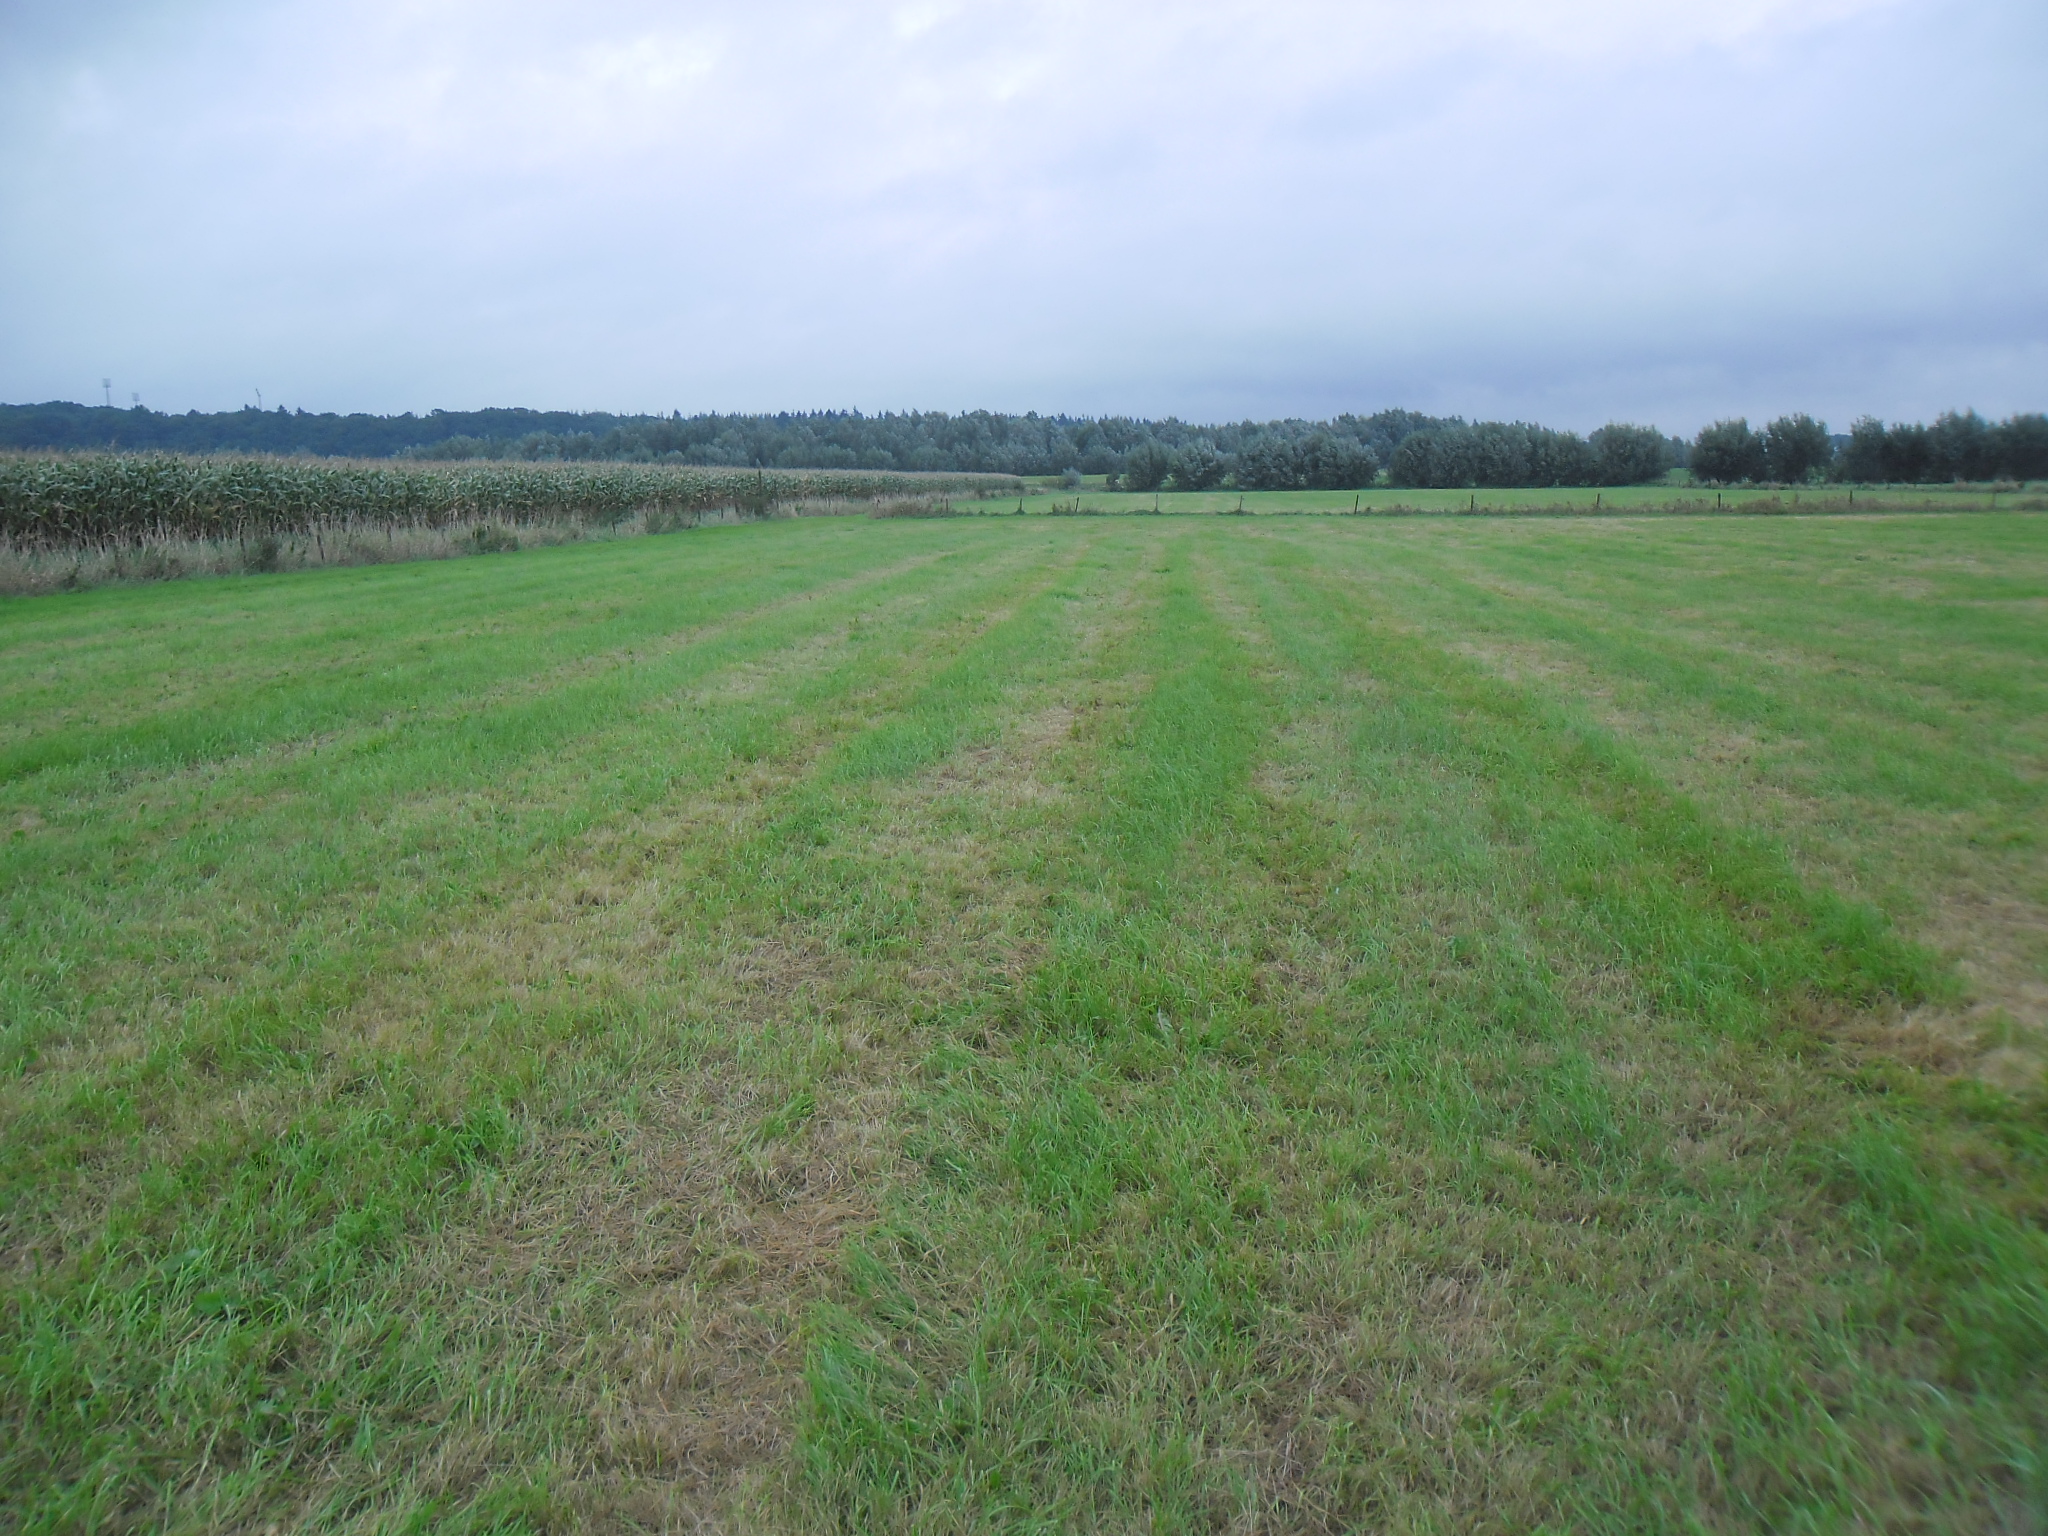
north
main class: Grassland
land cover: Grassland without tree/shrub cover
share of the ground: > 75 %
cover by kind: herbaceous plants 100 %
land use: Agriculture (excluding fallow land and kitchen gardens)
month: September
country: NL
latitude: 51.9578
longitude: 5.7058
